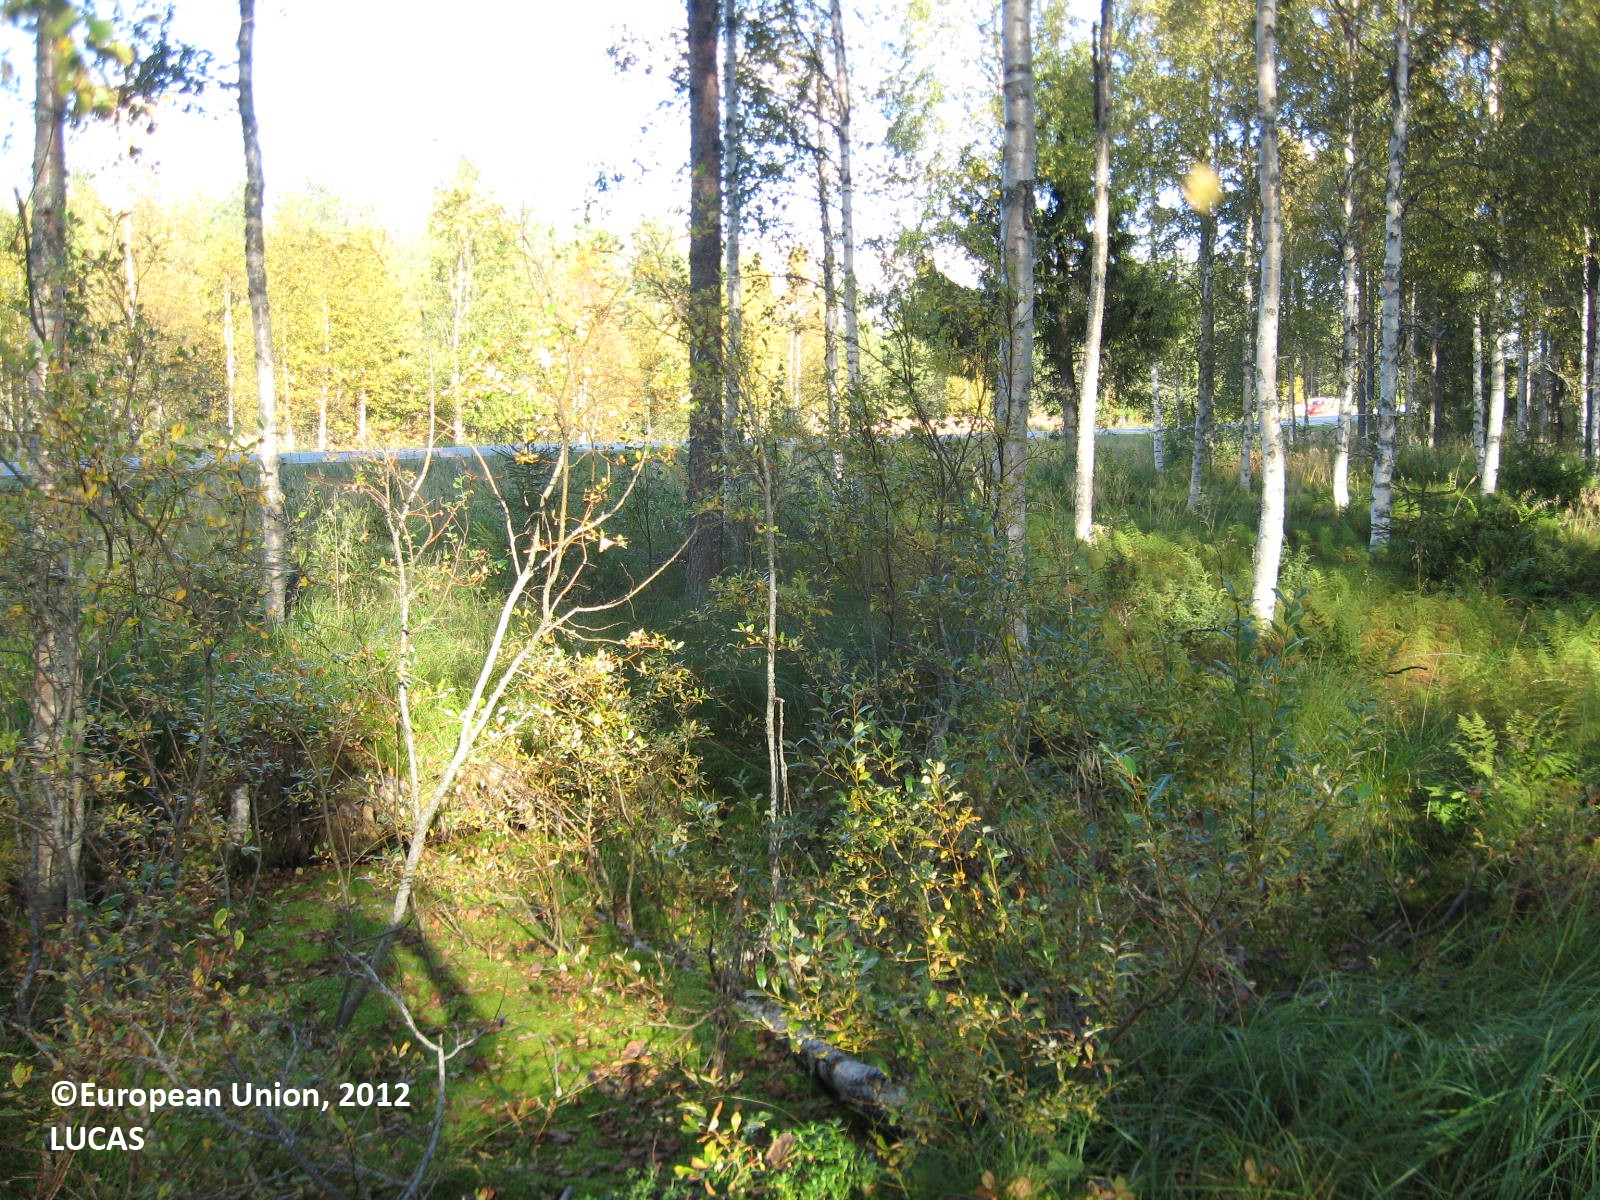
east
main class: Woodland
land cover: Other mixed woodland
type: boreal forest
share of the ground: > 75 %
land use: Forestry
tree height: > 5 m
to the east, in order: Other mixed woodland; Ditches and canals; Shruby margins; Grass margins; Paved roads, cycling and walking lanes; Grass margins; Shruby margins; Ditches and canals; Grassland without tree/shrub cover; Pine dominated mixed woodland; Pine dominated coniferous woodland; Tracks; Pine dominated coniferous woodland; Other mixed woodland; Pine dominated coniferous woodland
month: August
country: FI
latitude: 63.9728
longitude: 29.6521
